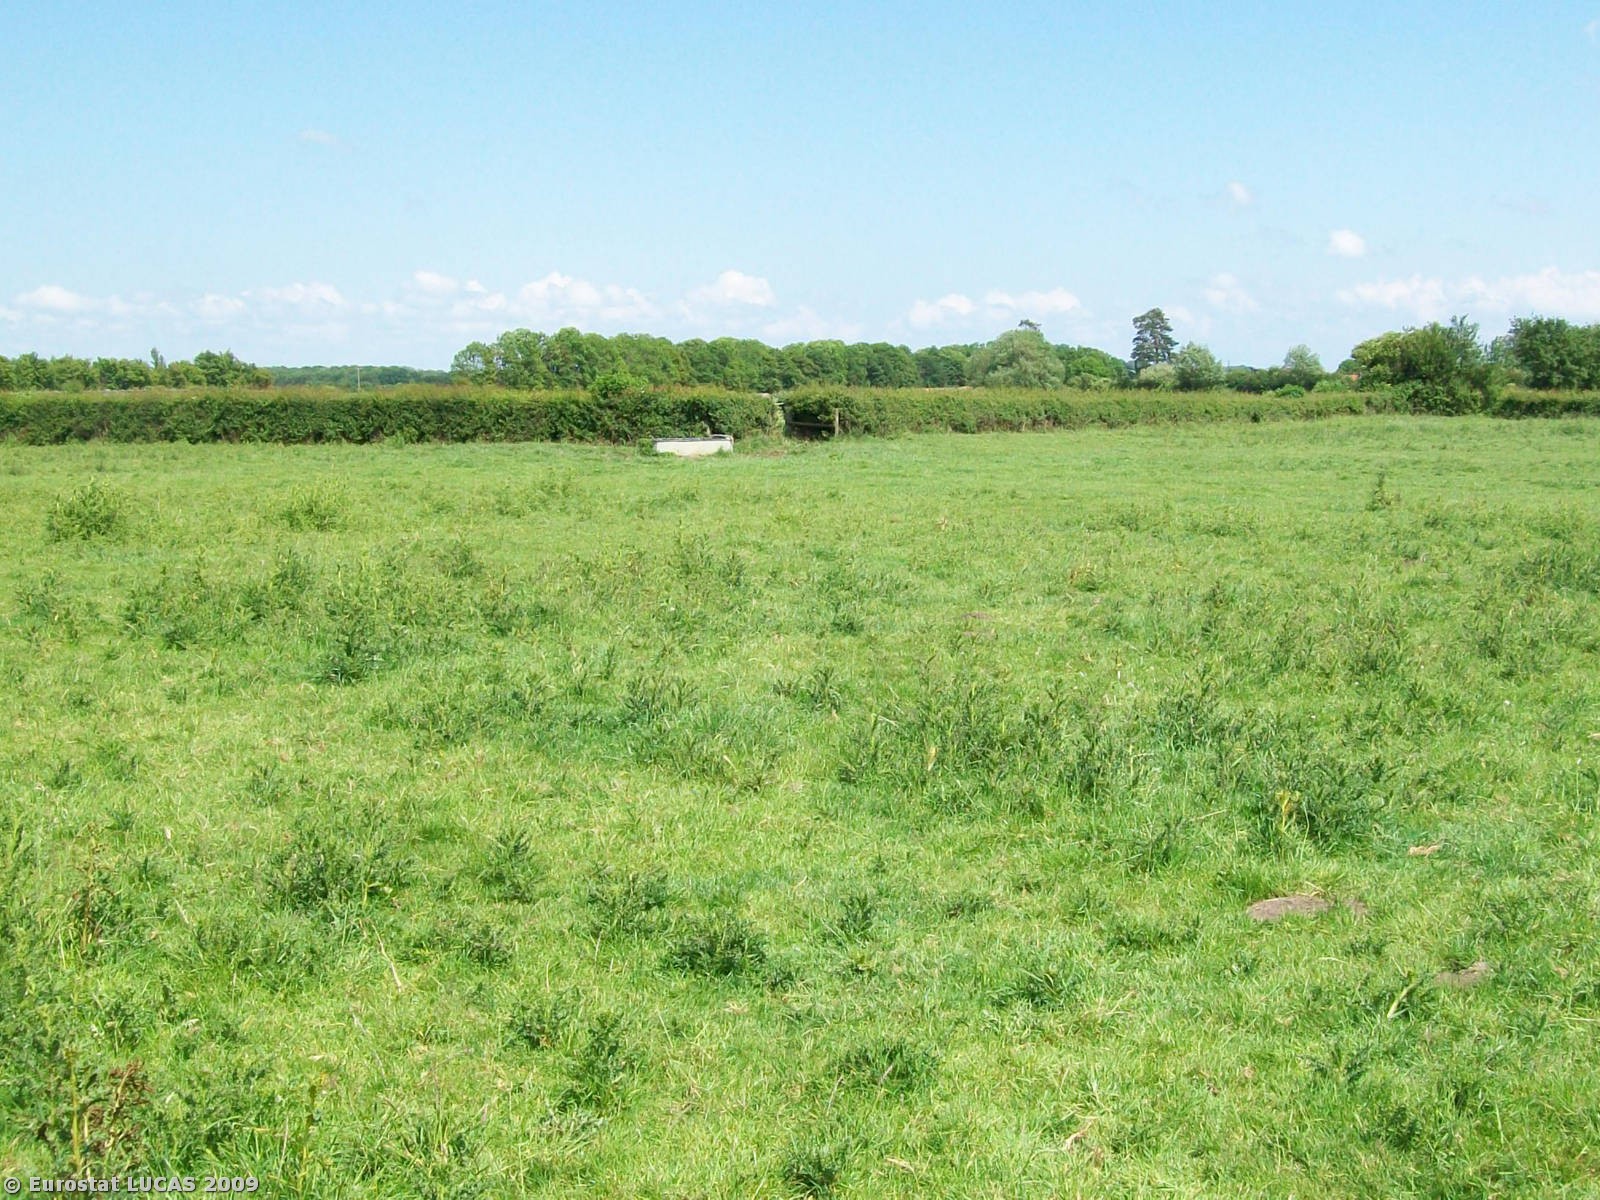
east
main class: Grassland
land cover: Grassland without tree/shrub cover
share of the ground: > 75 %
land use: Agriculture (excluding fallow land and kitchen gardens)
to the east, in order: Grassland without tree/shrub cover; Managed hedges; Grassland without tree/shrub cover
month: June
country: GB
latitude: 51.0228
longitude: -2.6576
